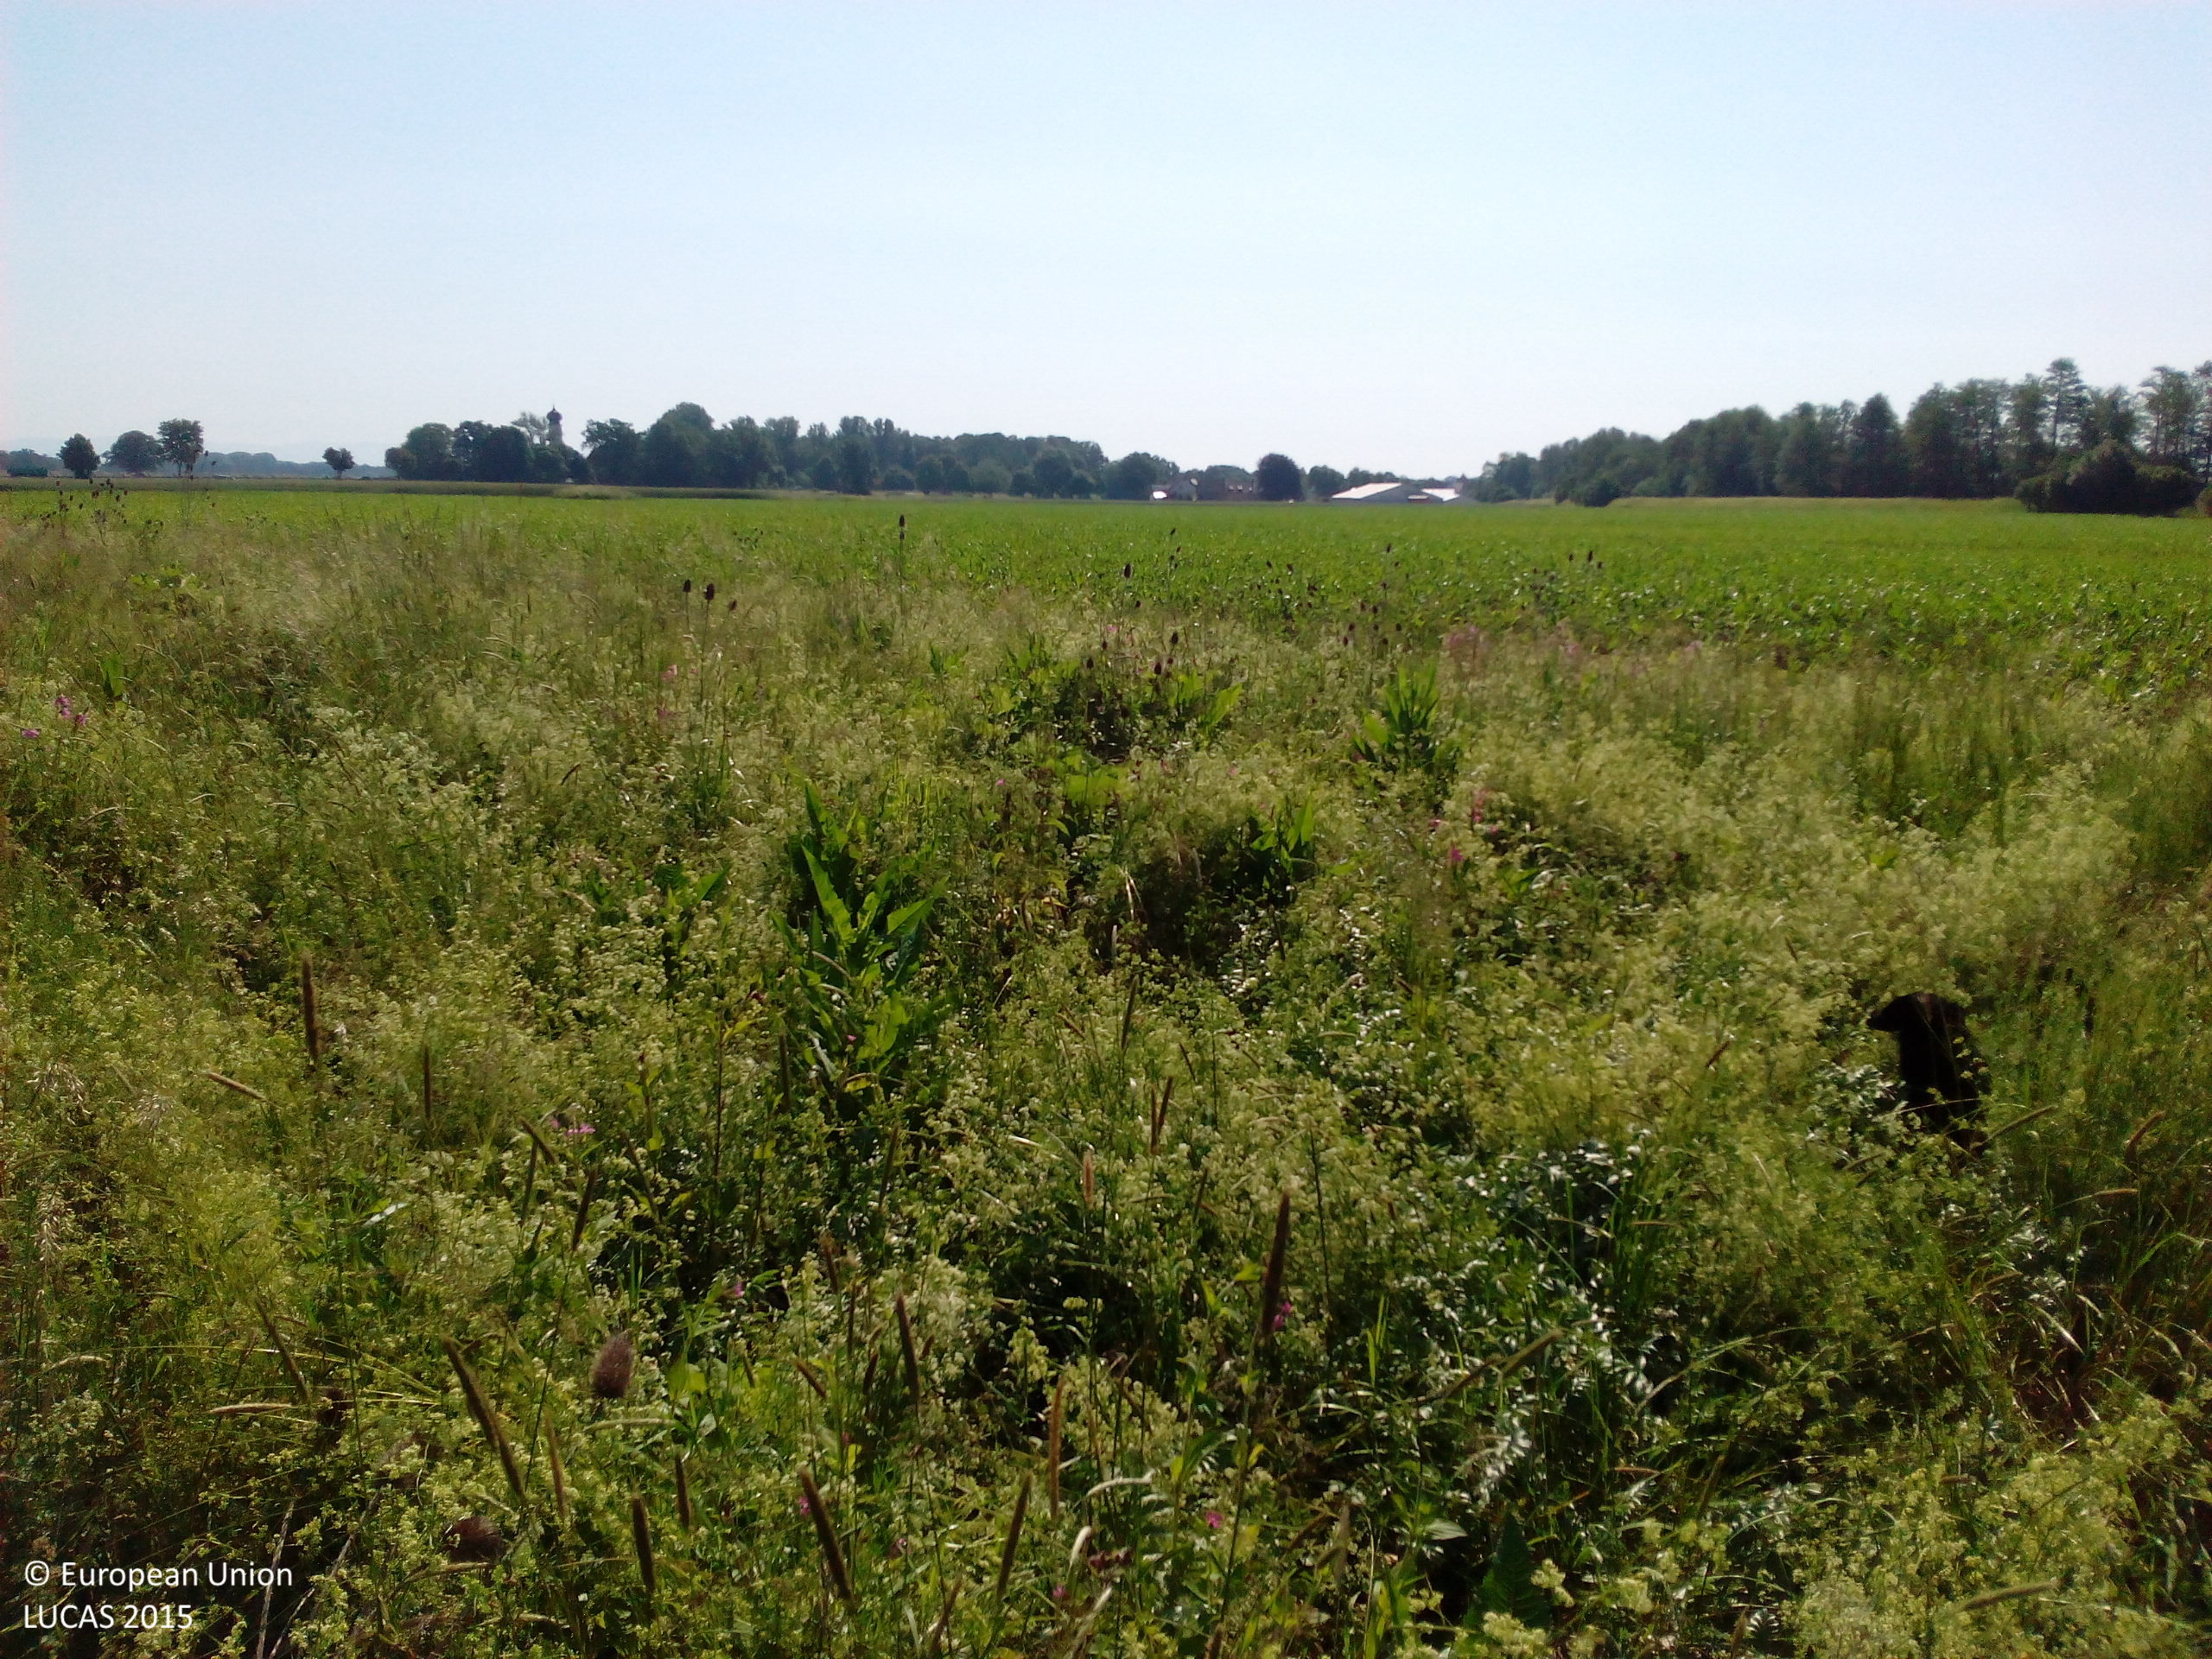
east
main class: Grassland
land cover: Spontaneously vegetated surfaces
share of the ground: > 75 %
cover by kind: herbaceous plants 100 %
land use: Fallow land
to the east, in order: Spontaneously vegetated surfaces; Maize
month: June
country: DE
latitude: 48.9171
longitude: 12.4147
